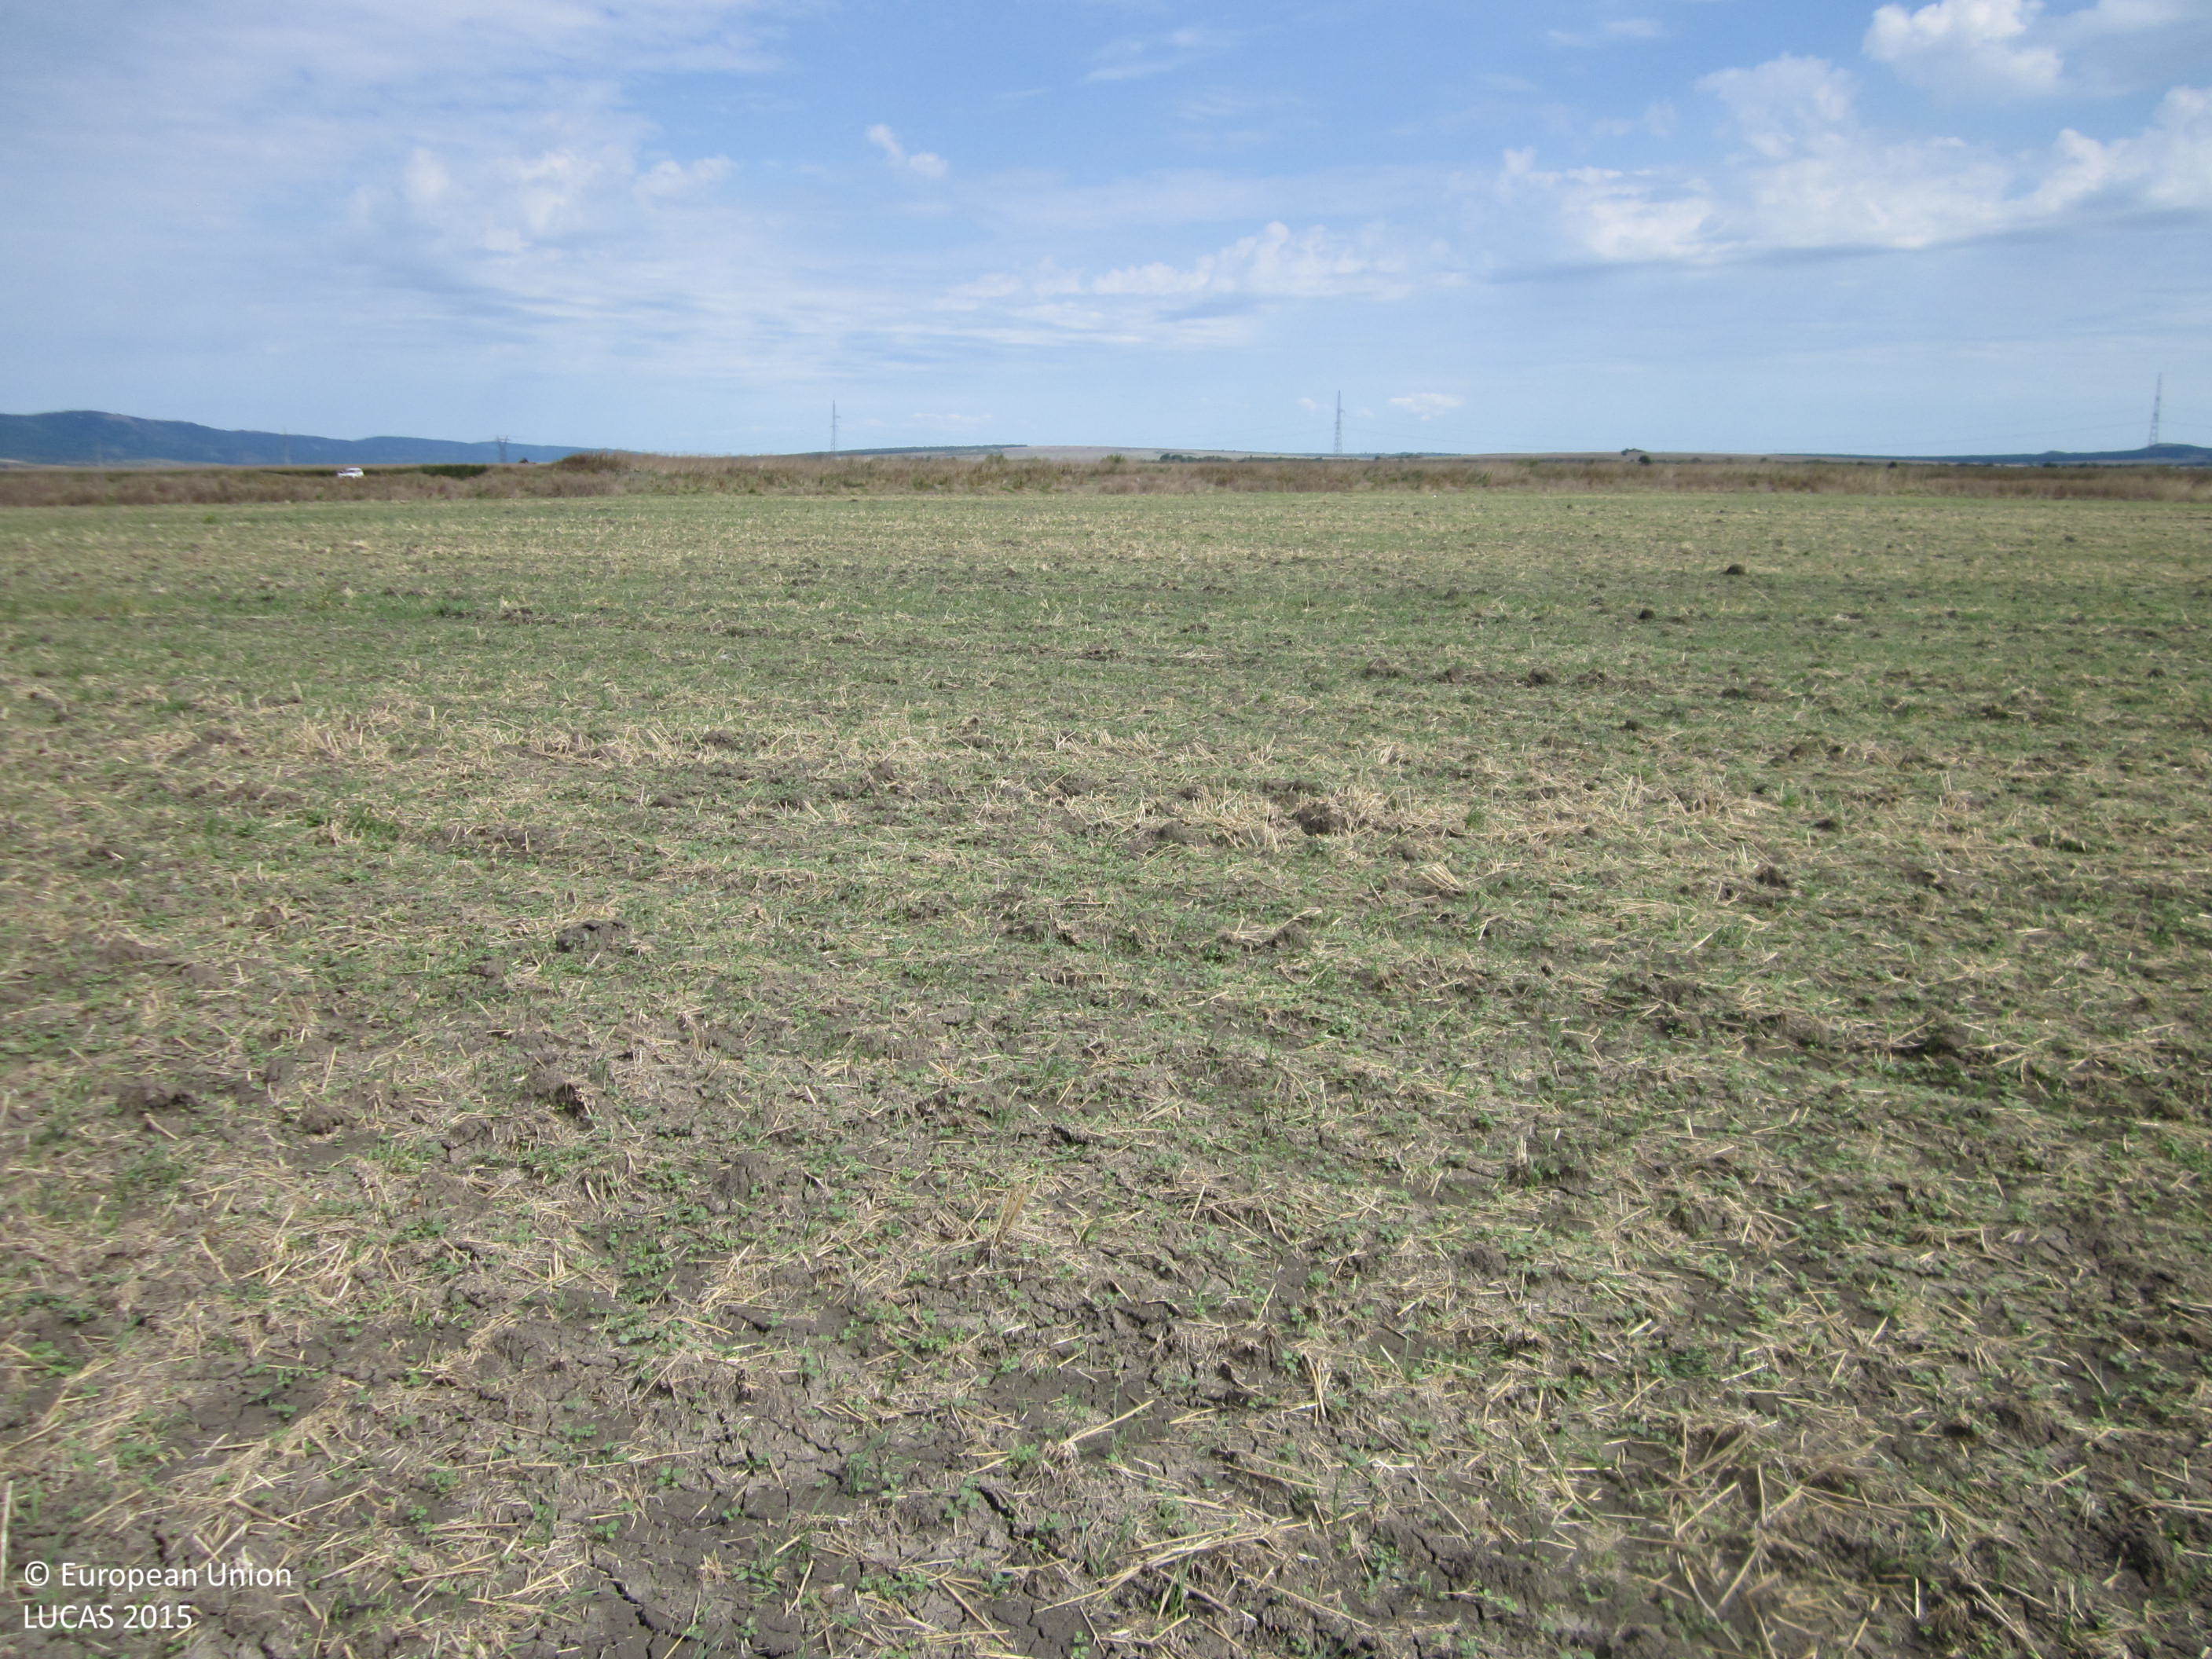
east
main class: Cropland
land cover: Common wheat
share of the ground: 10 - 25 %
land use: Agriculture (excluding fallow land and kitchen gardens)
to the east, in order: Common wheat; Grassland without tree/shrub cover
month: September
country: BG
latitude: 42.6977
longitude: 26.9894
